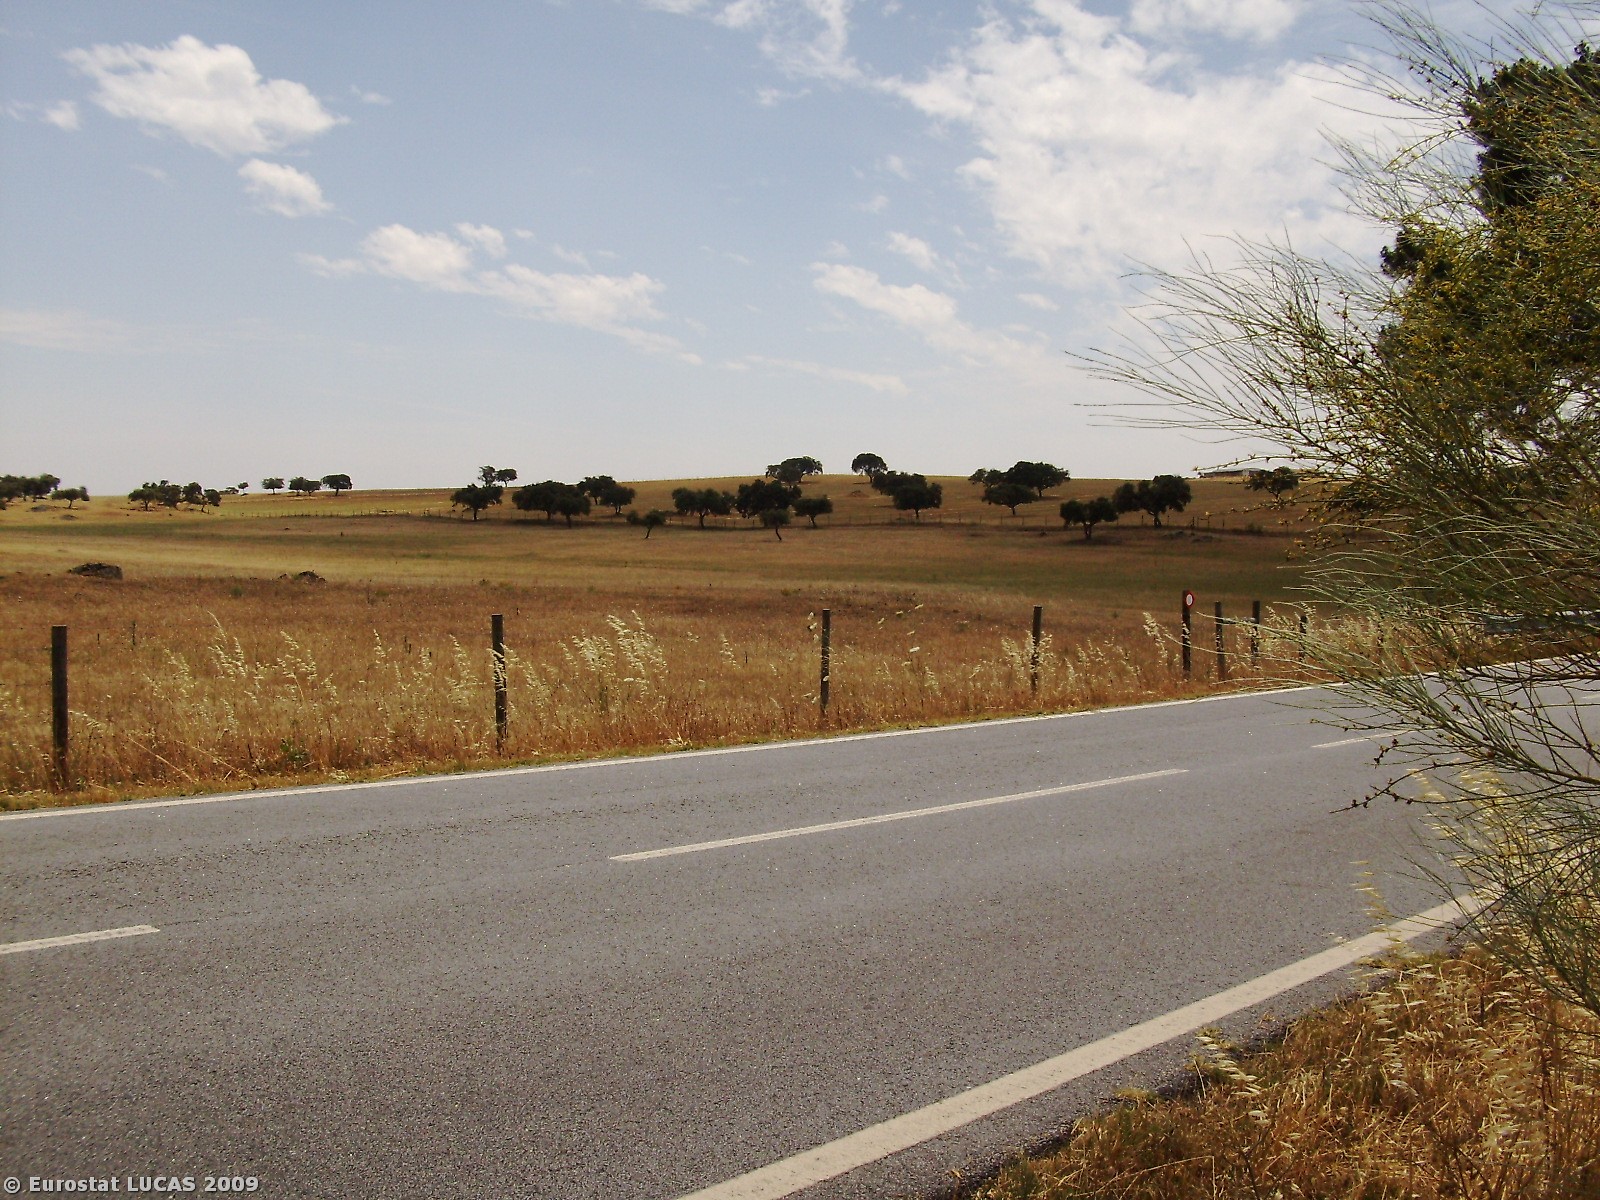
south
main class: Grassland
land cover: Spontaneously vegetated surfaces
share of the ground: > 75 %
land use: Fallow land
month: June
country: PT
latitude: 39.1195
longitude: -7.4221
